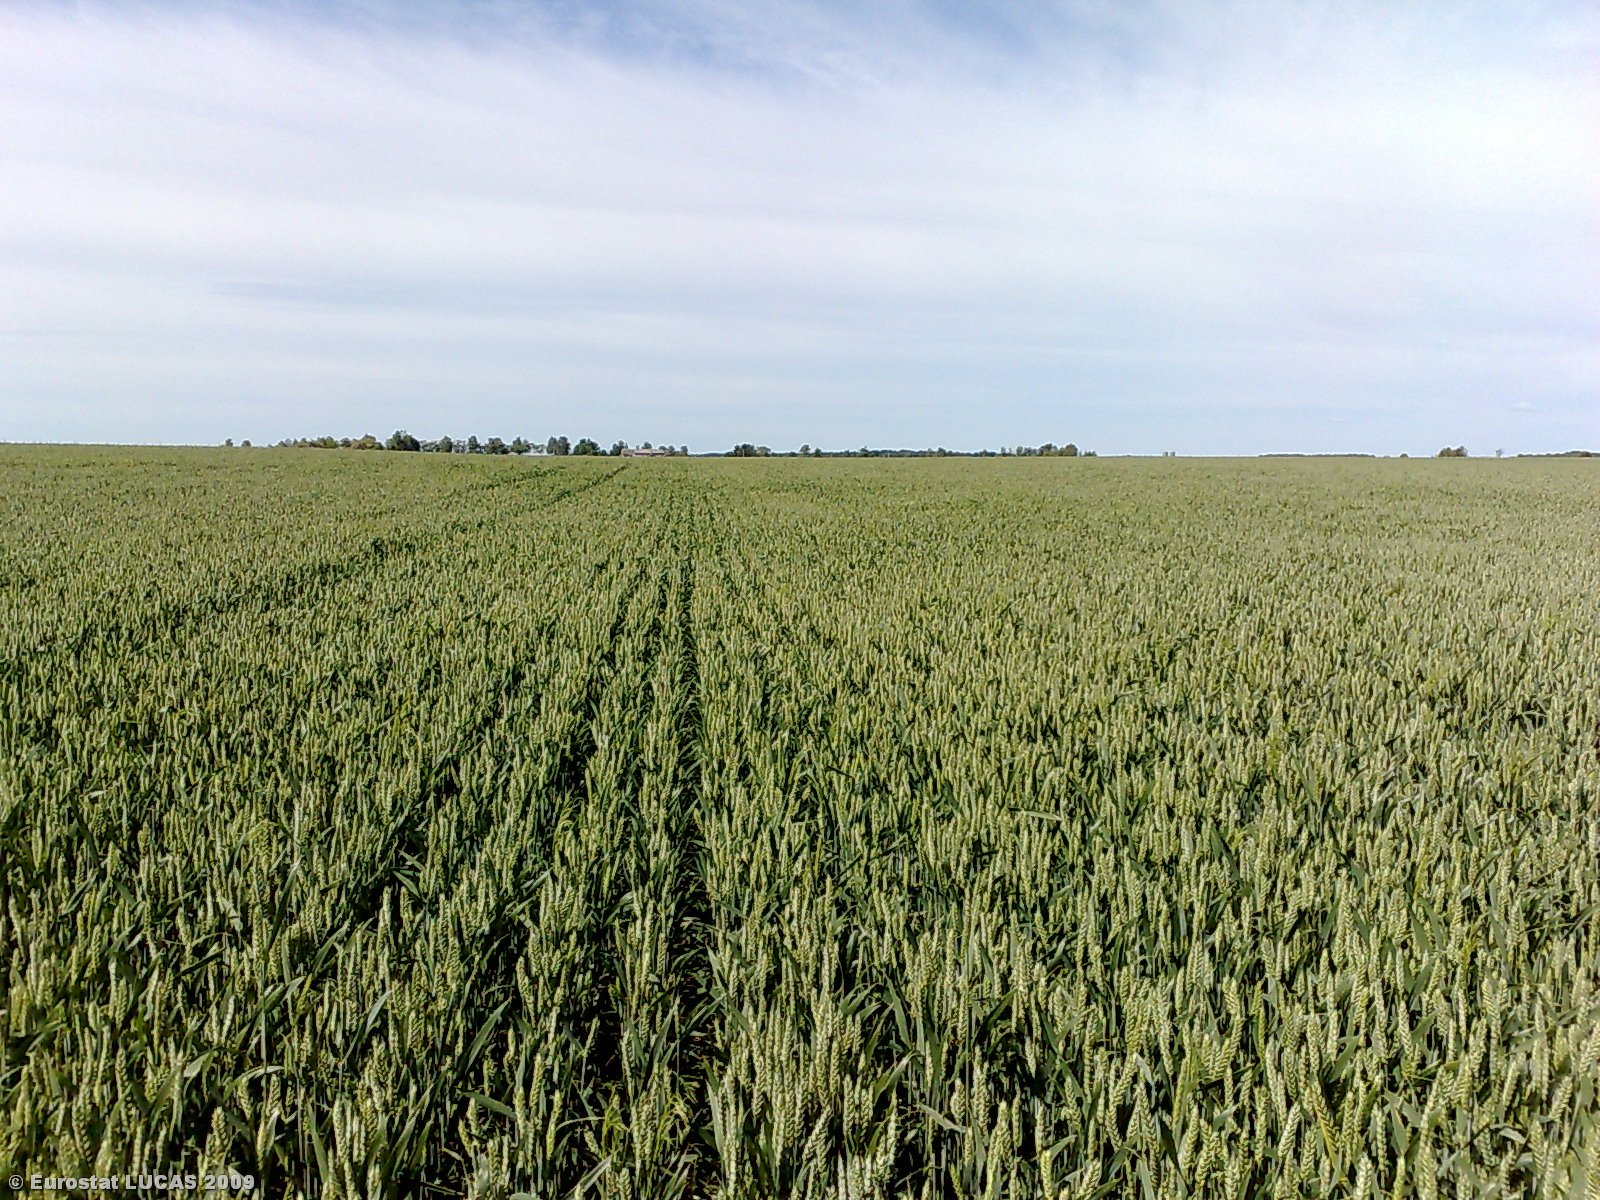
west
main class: Cropland
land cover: Common wheat
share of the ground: > 75 %
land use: Agriculture (excluding fallow land and kitchen gardens)
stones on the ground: < 10 %
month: June
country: LT
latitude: 55.8536
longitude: 24.0015
